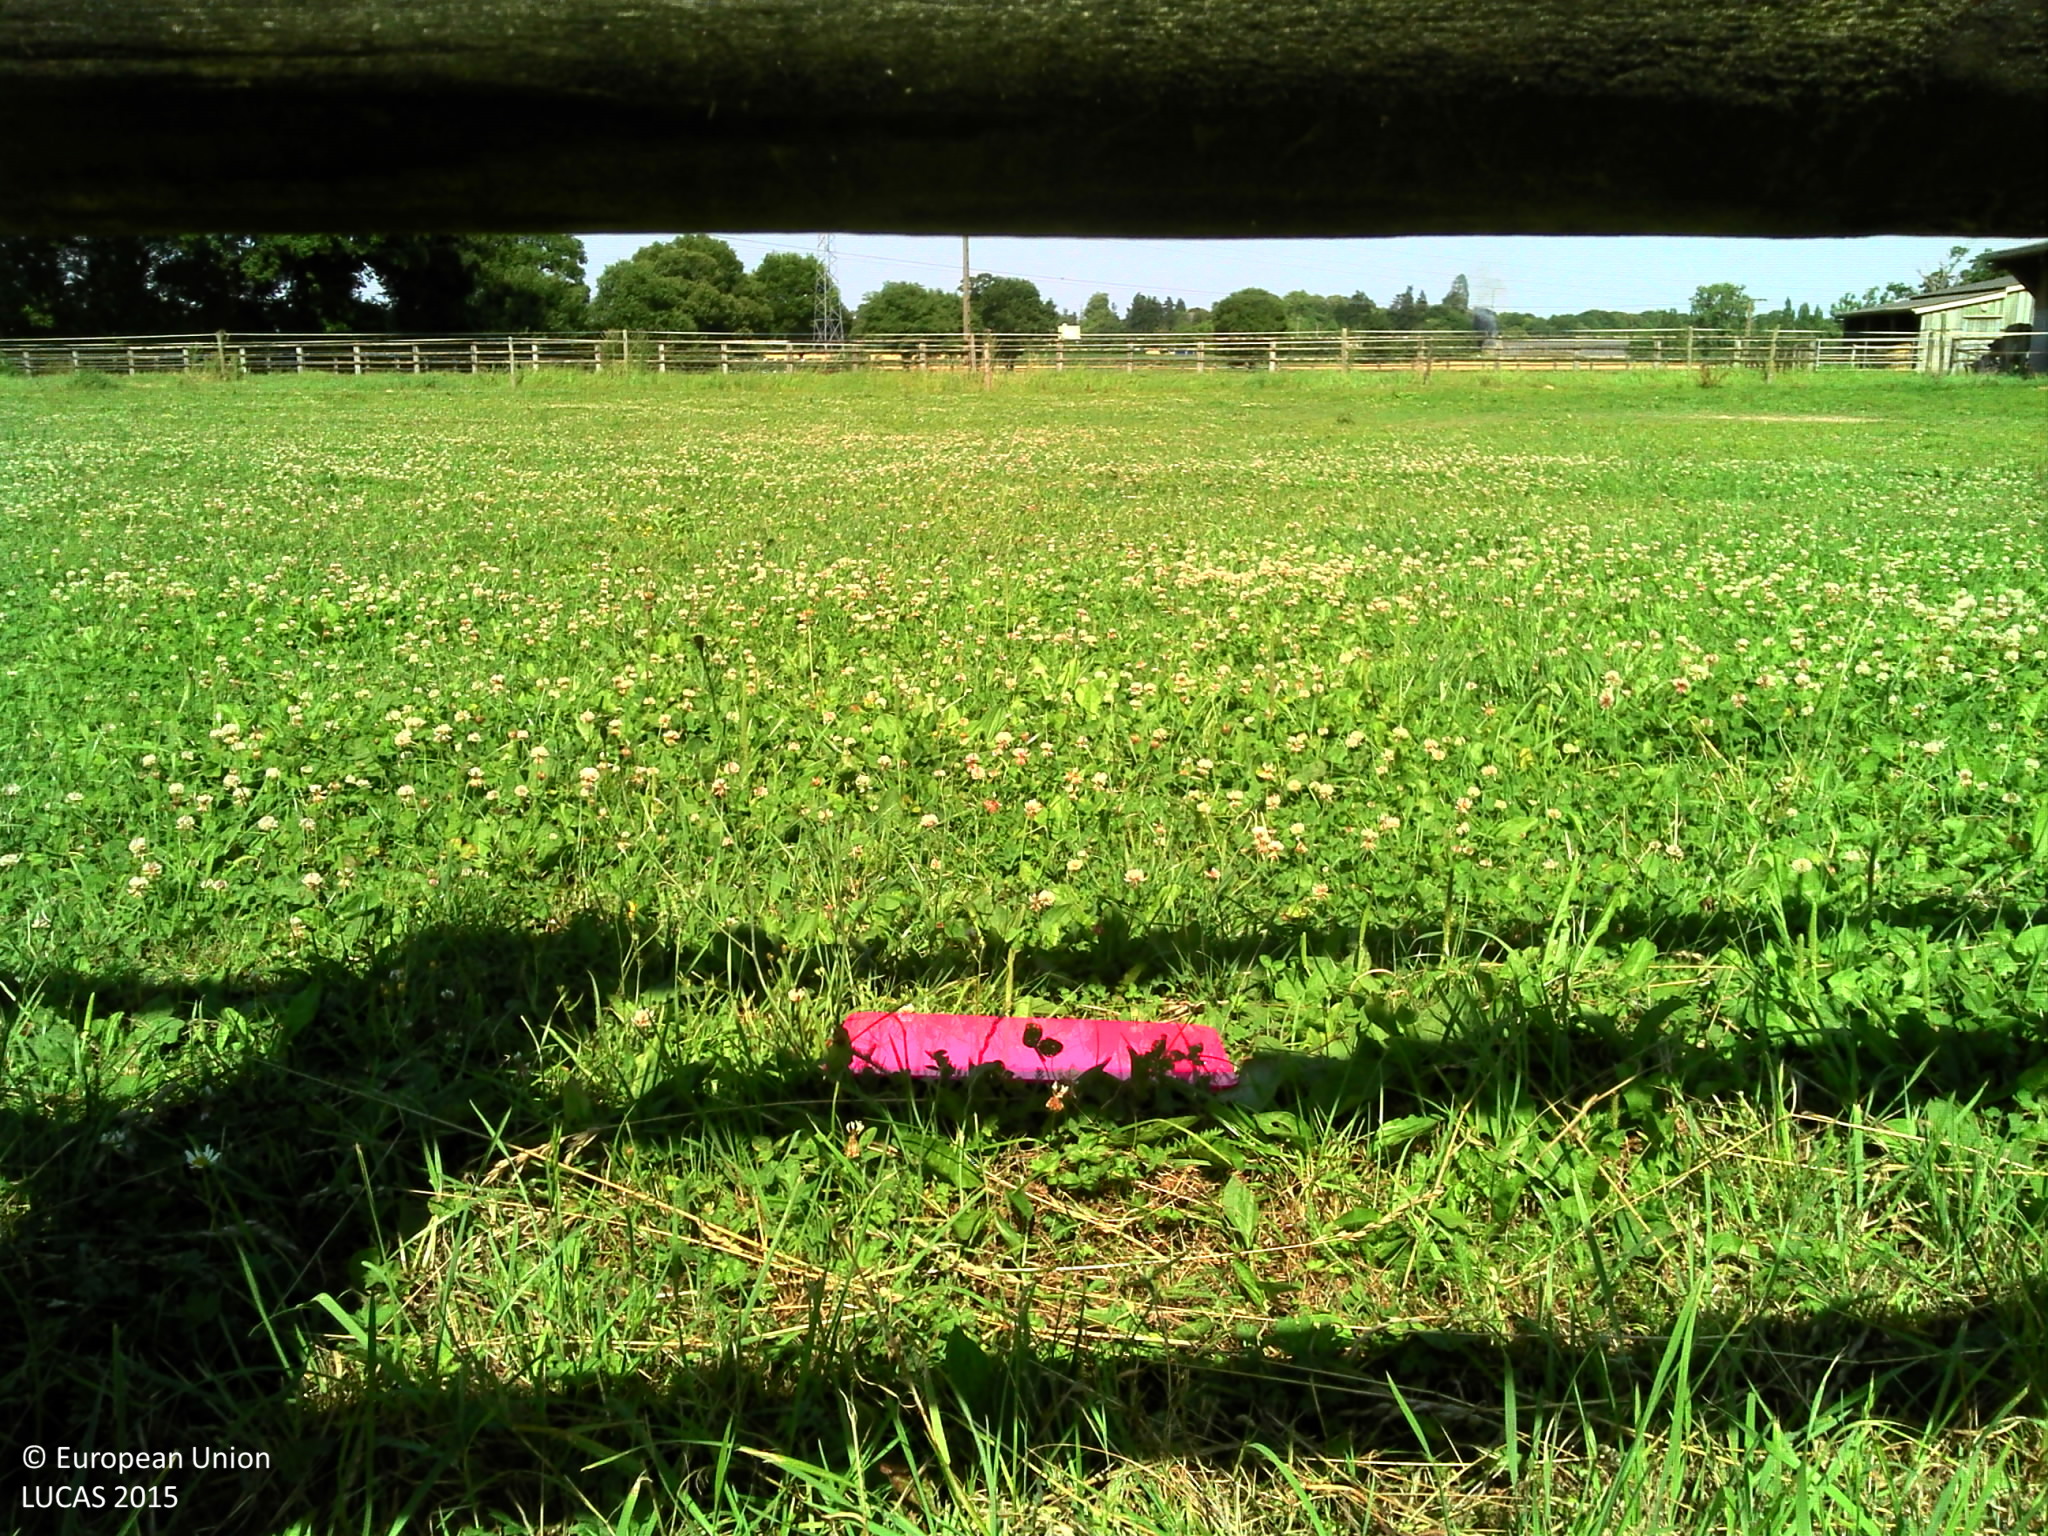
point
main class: Grassland
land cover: Grassland without tree/shrub cover
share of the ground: > 75 %
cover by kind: herbaceous plants 100 %
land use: Sport
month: July
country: FR
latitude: 48.0515
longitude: -1.1900
